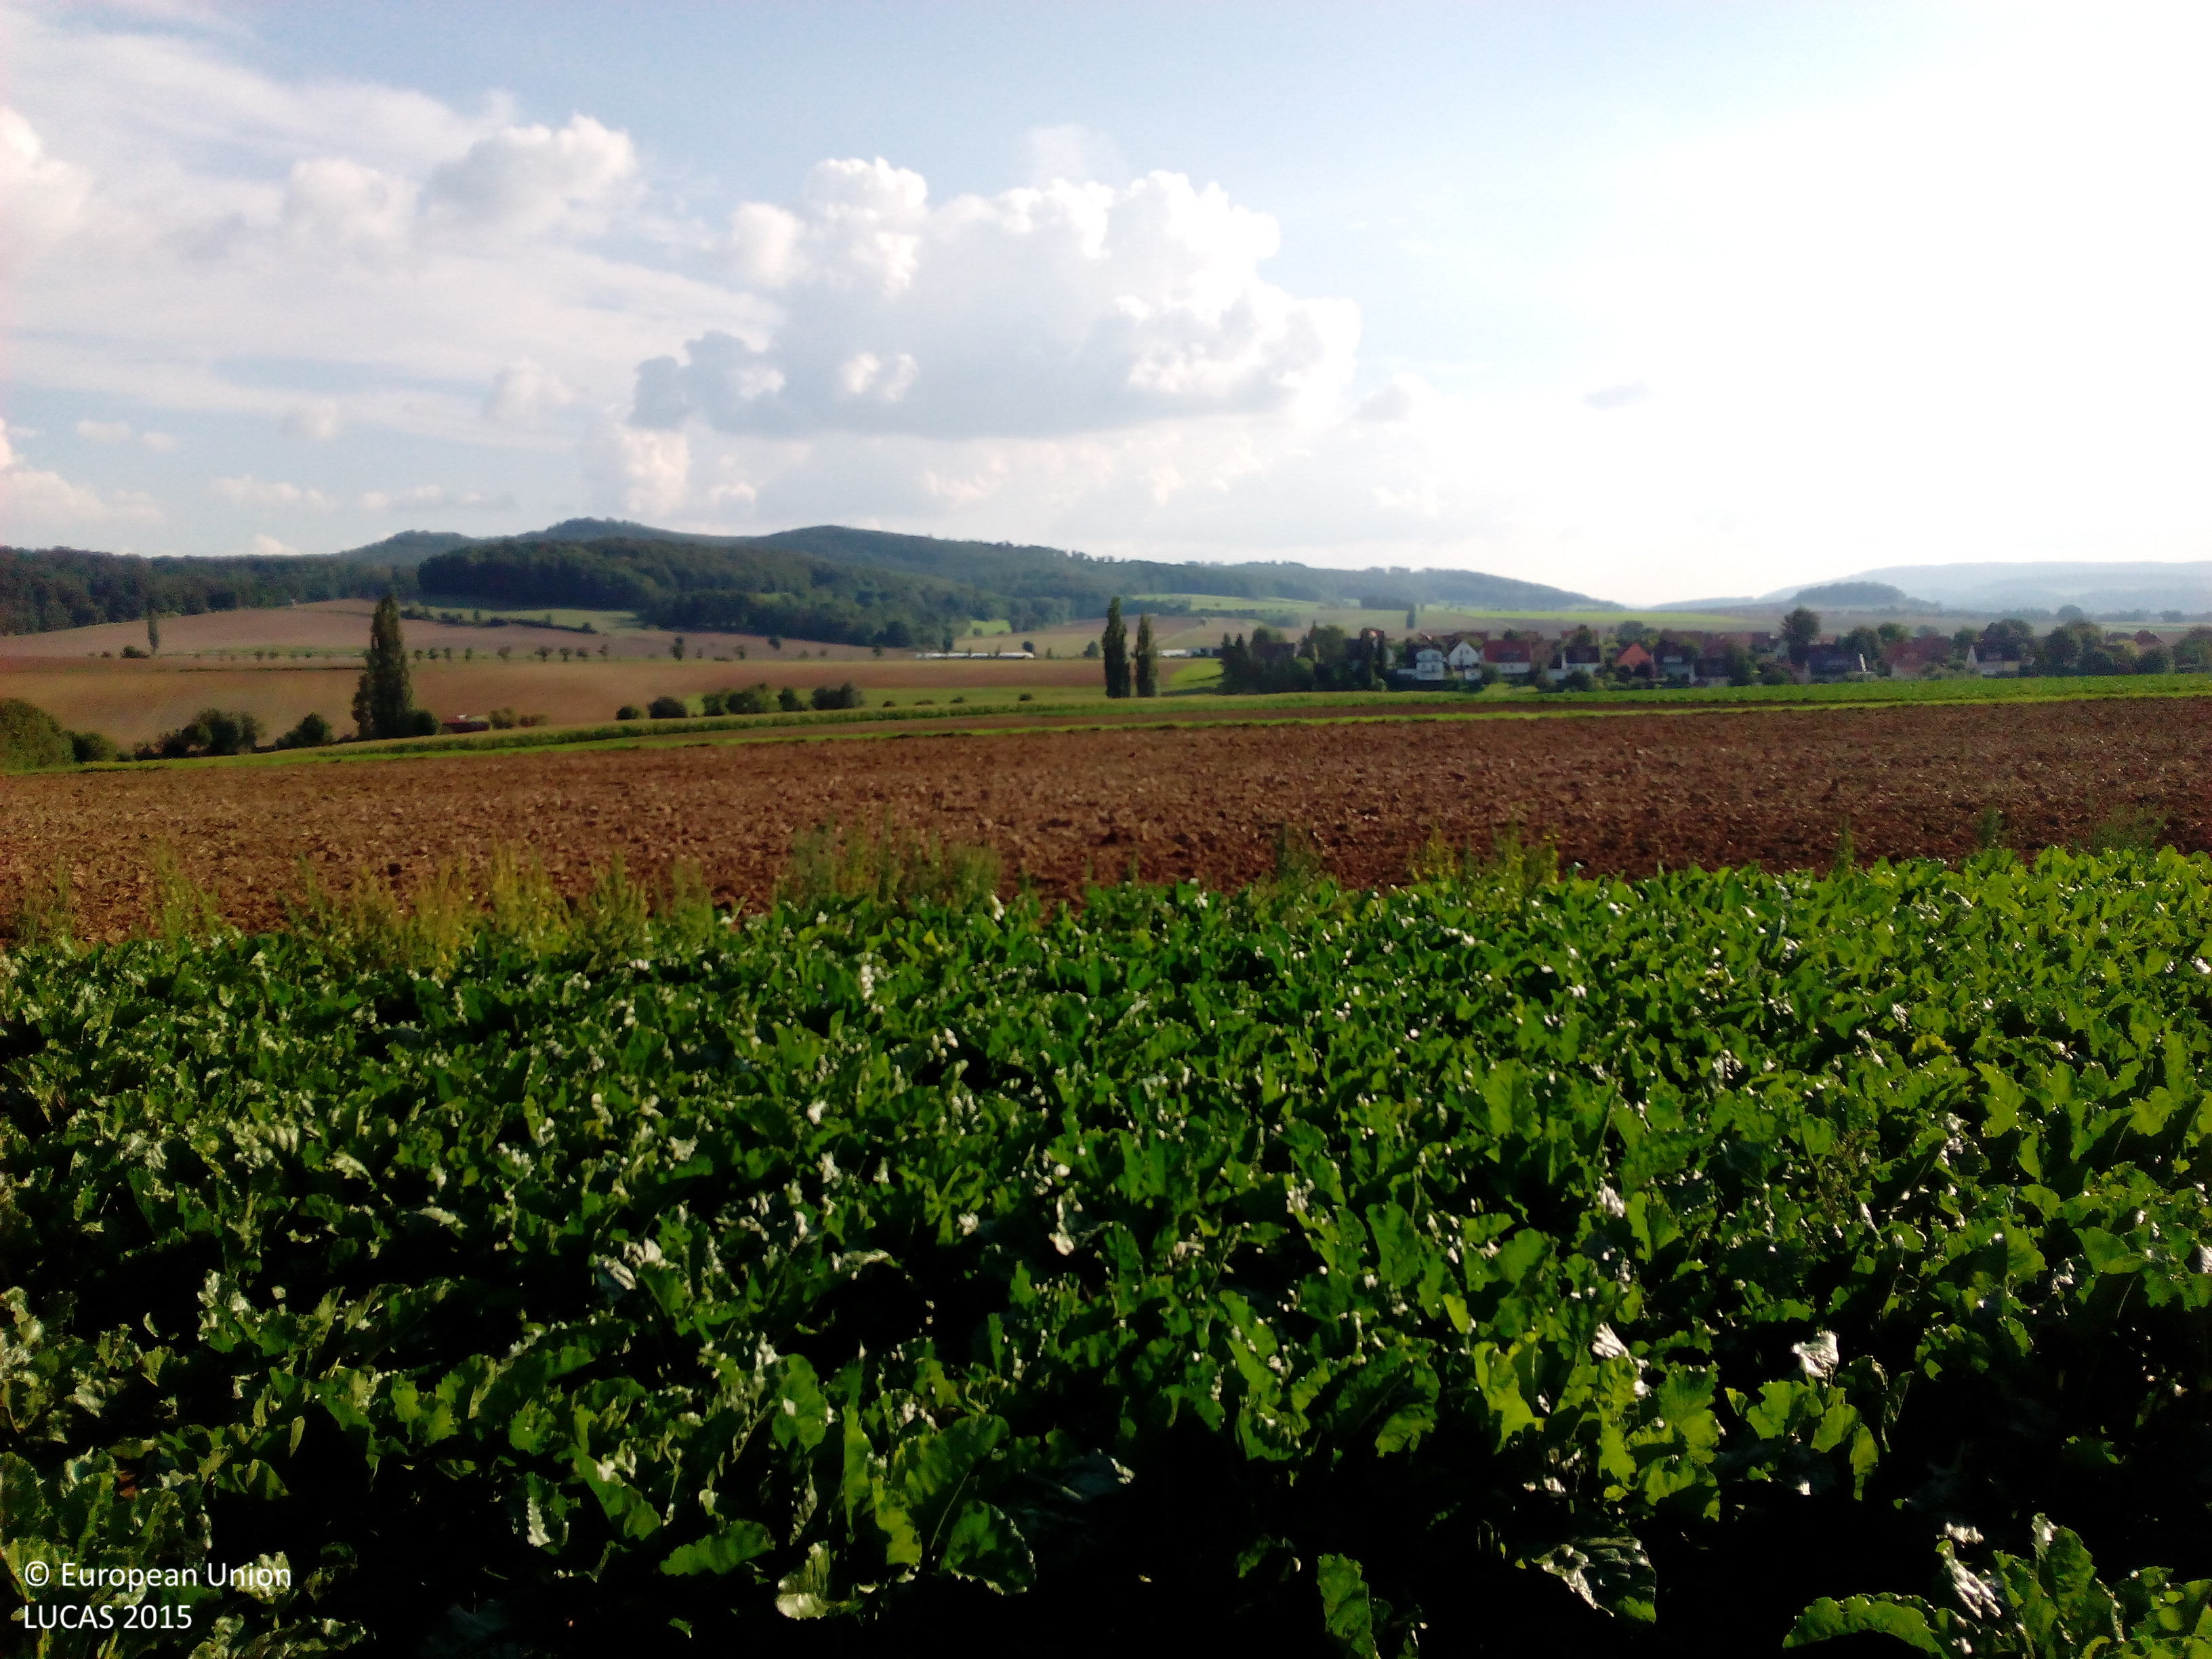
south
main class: Cropland
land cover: Sugar beet
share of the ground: > 75 %
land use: Agriculture (excluding fallow land and kitchen gardens)
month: September
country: DE
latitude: 51.4607
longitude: 9.9568
